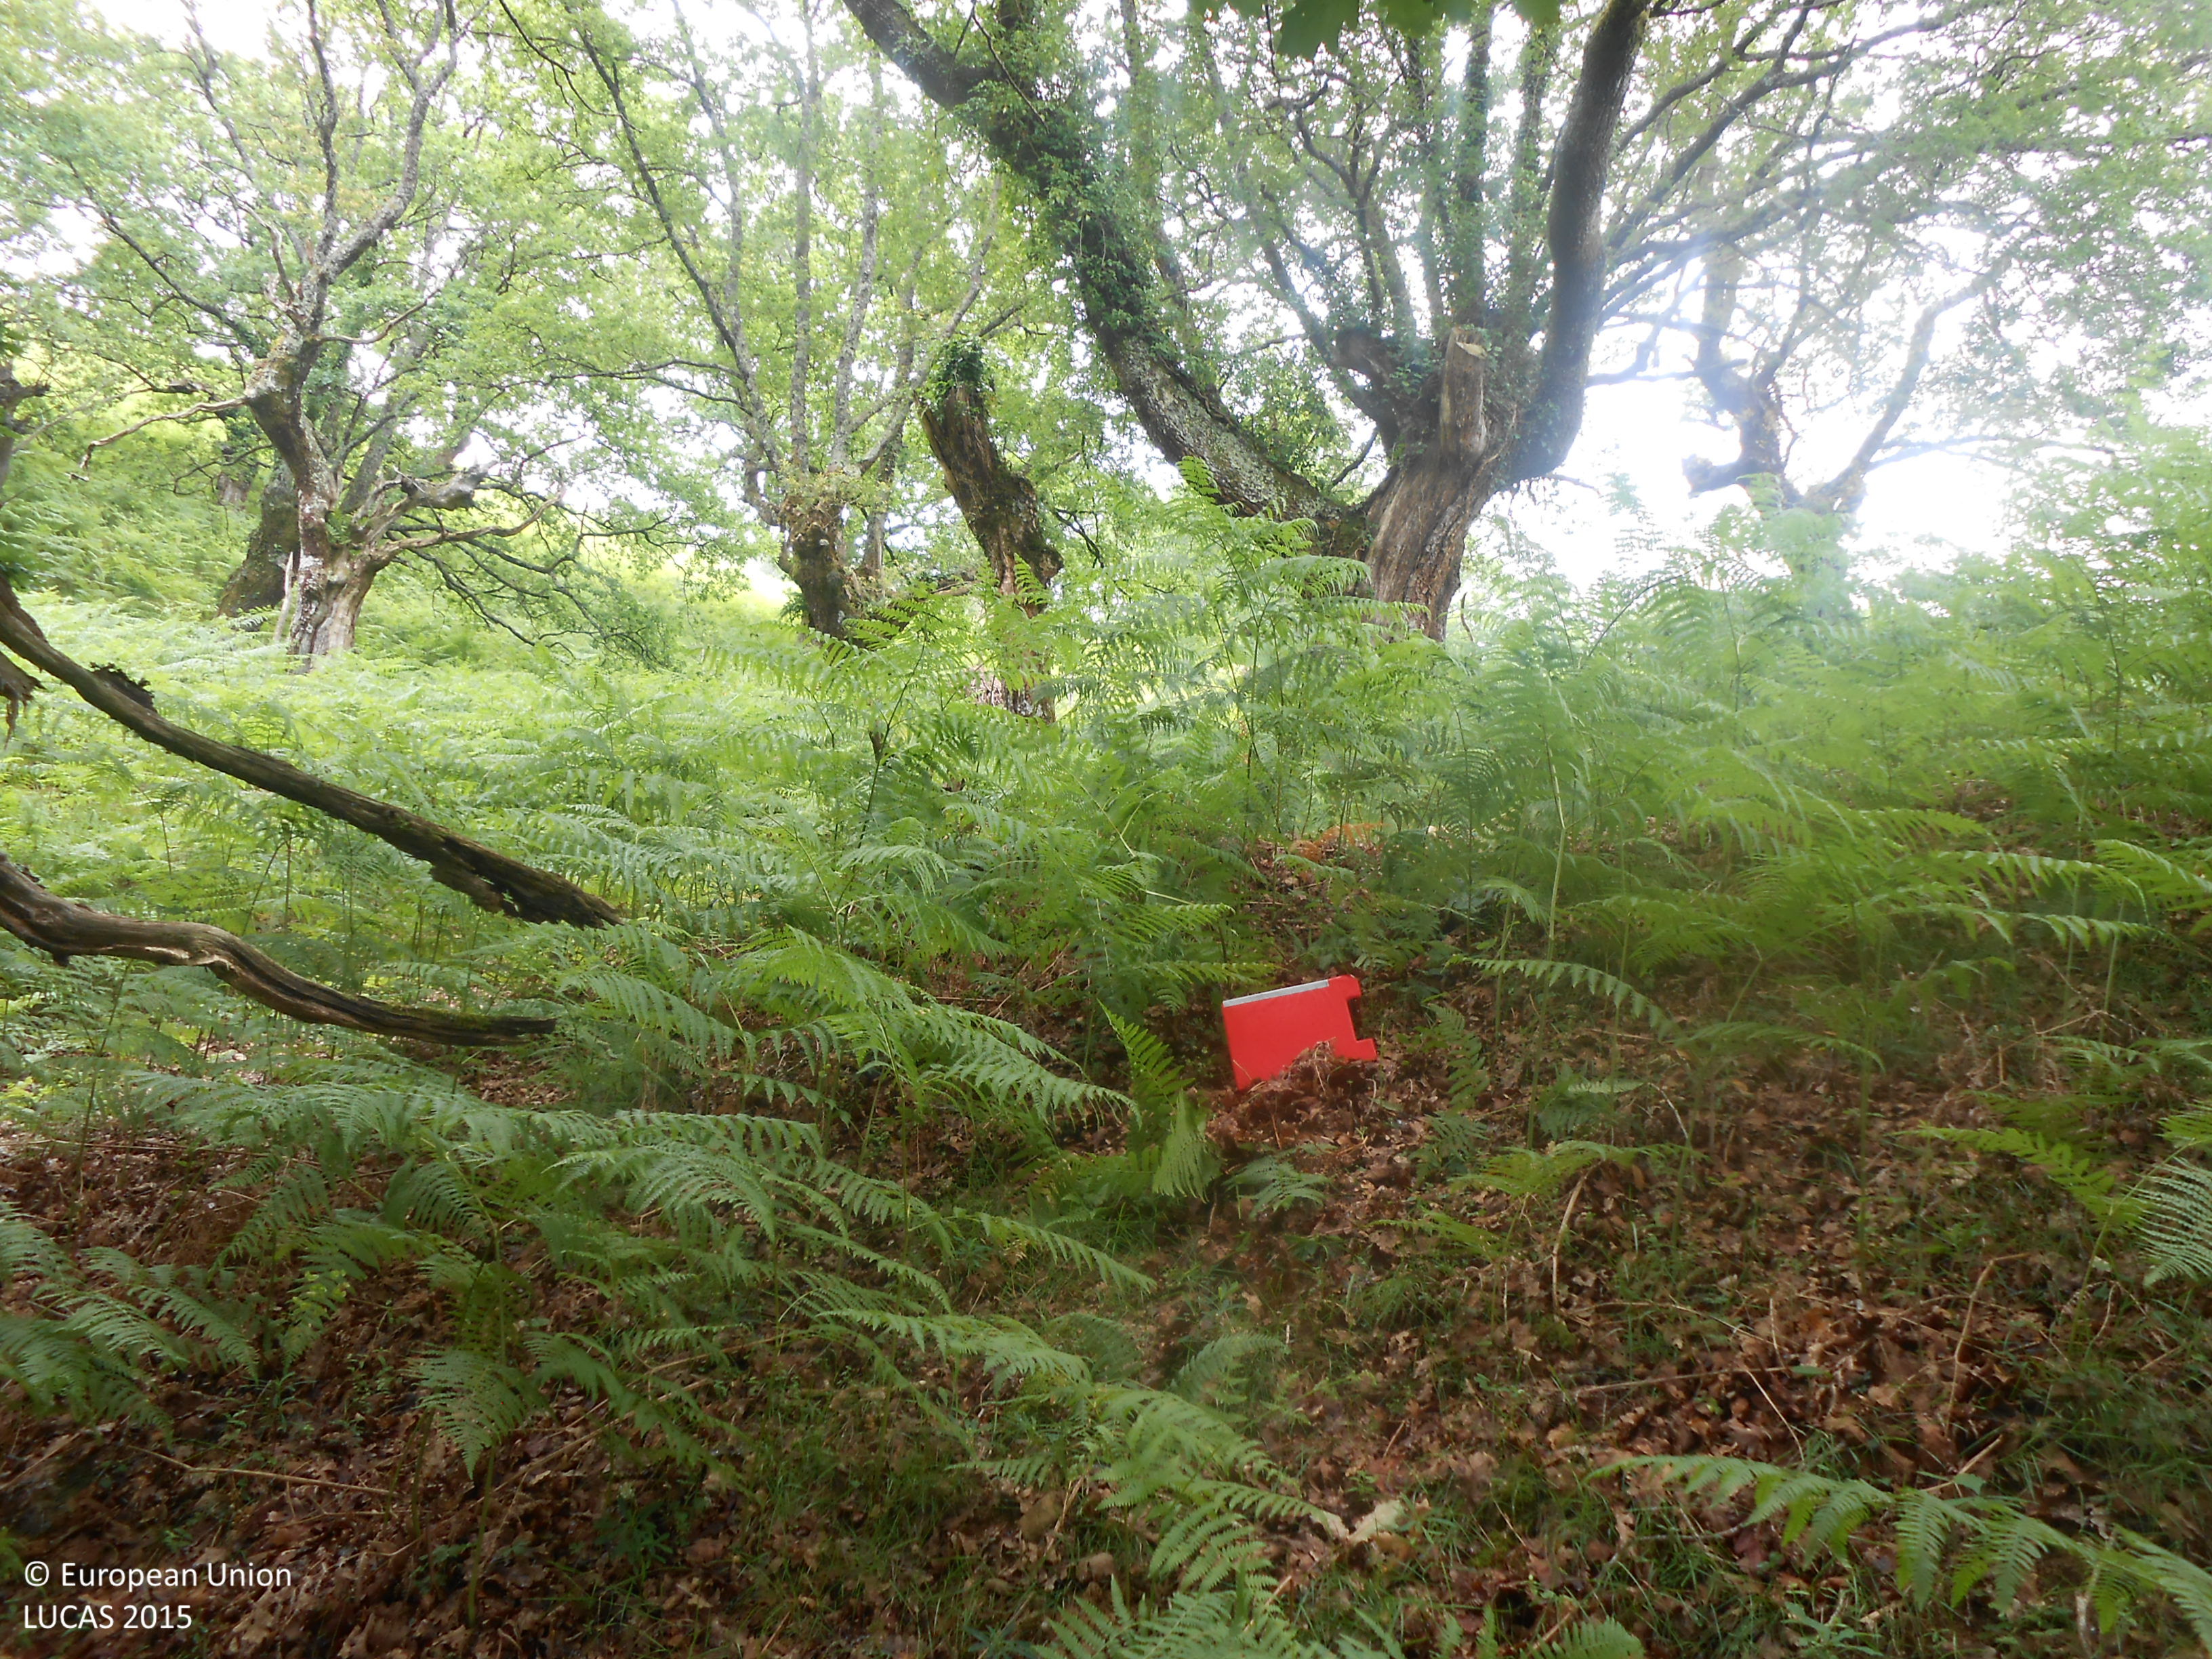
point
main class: Woodland
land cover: Broadleaved woodland
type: acidophilous oak and oak-birch forest
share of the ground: > 75 %
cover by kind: broadleaved forest trees 60 %, herbaceous plants 40 %
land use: Forestry
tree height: > 5 m
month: June
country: ES
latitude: 43.2417
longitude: -1.6062
